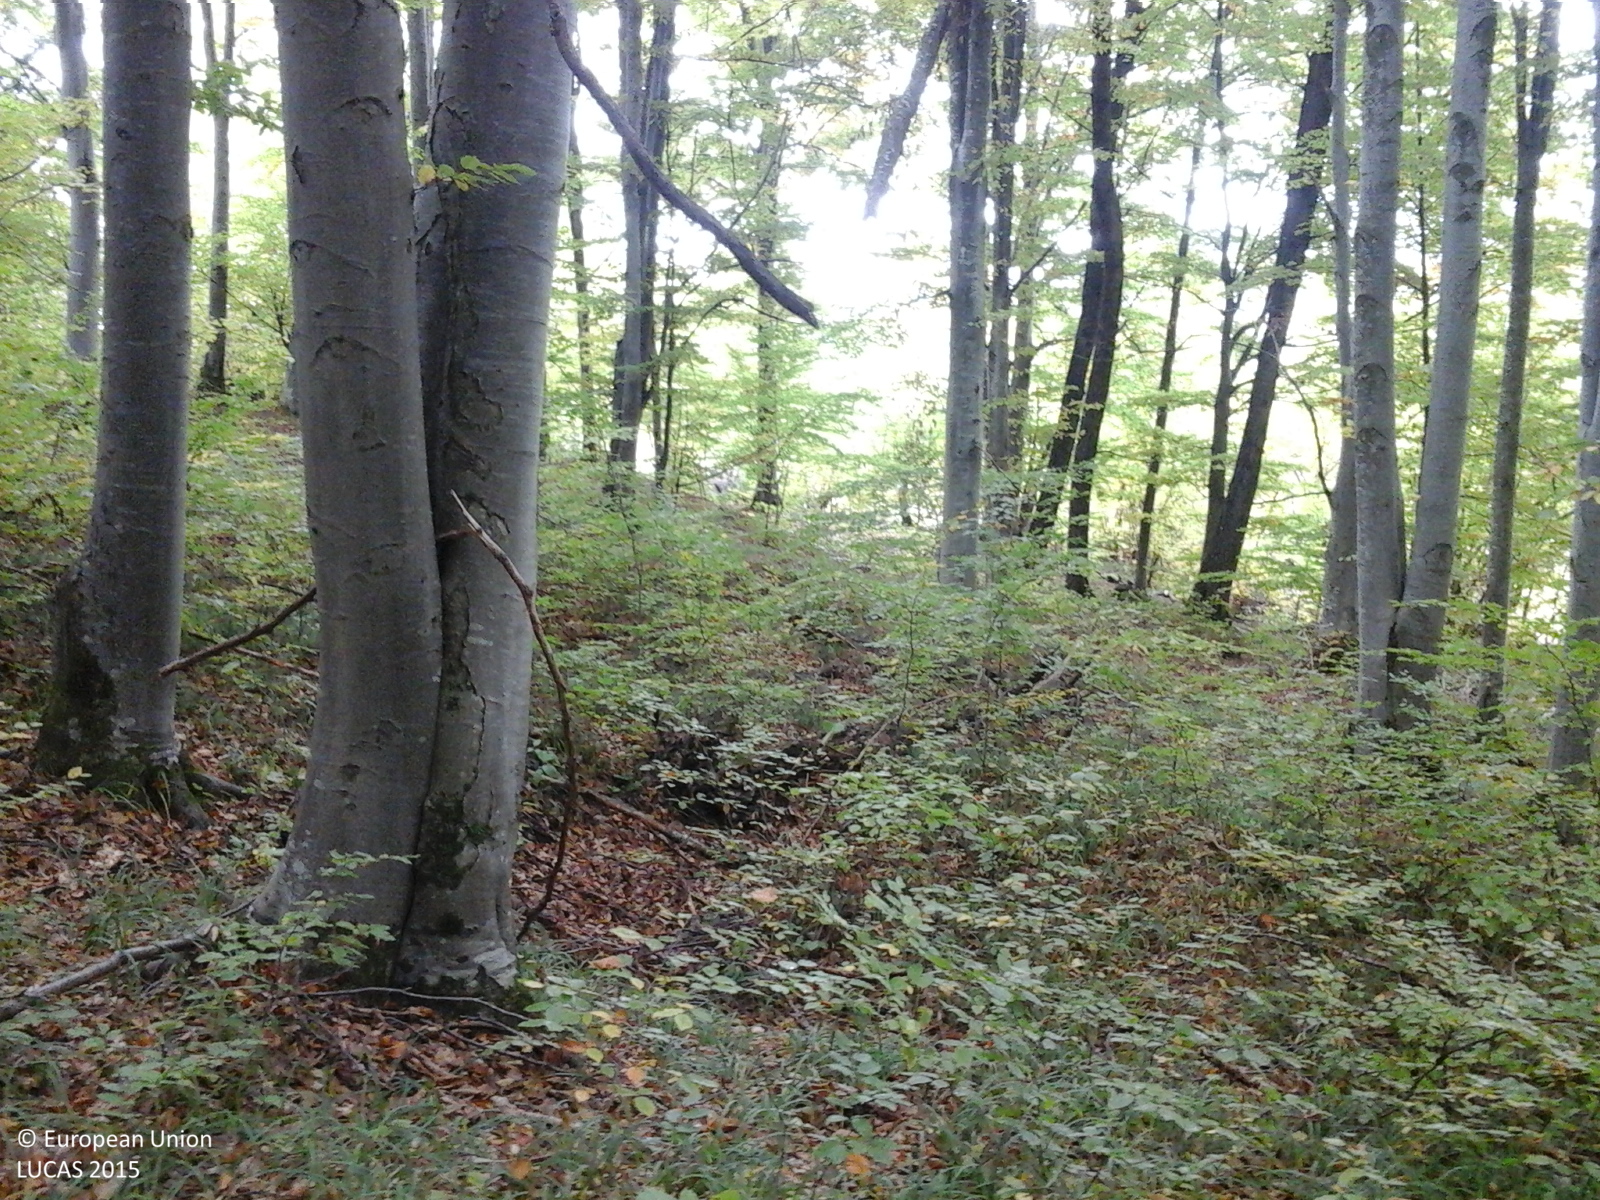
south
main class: Woodland
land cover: Broadleaved woodland
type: beech forest
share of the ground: > 75 %
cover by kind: broadleaved forest trees 100 %
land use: Forestry
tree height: > 5 m
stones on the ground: 10 - 25 %
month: October
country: RO
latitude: 46.6540
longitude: 25.0350
